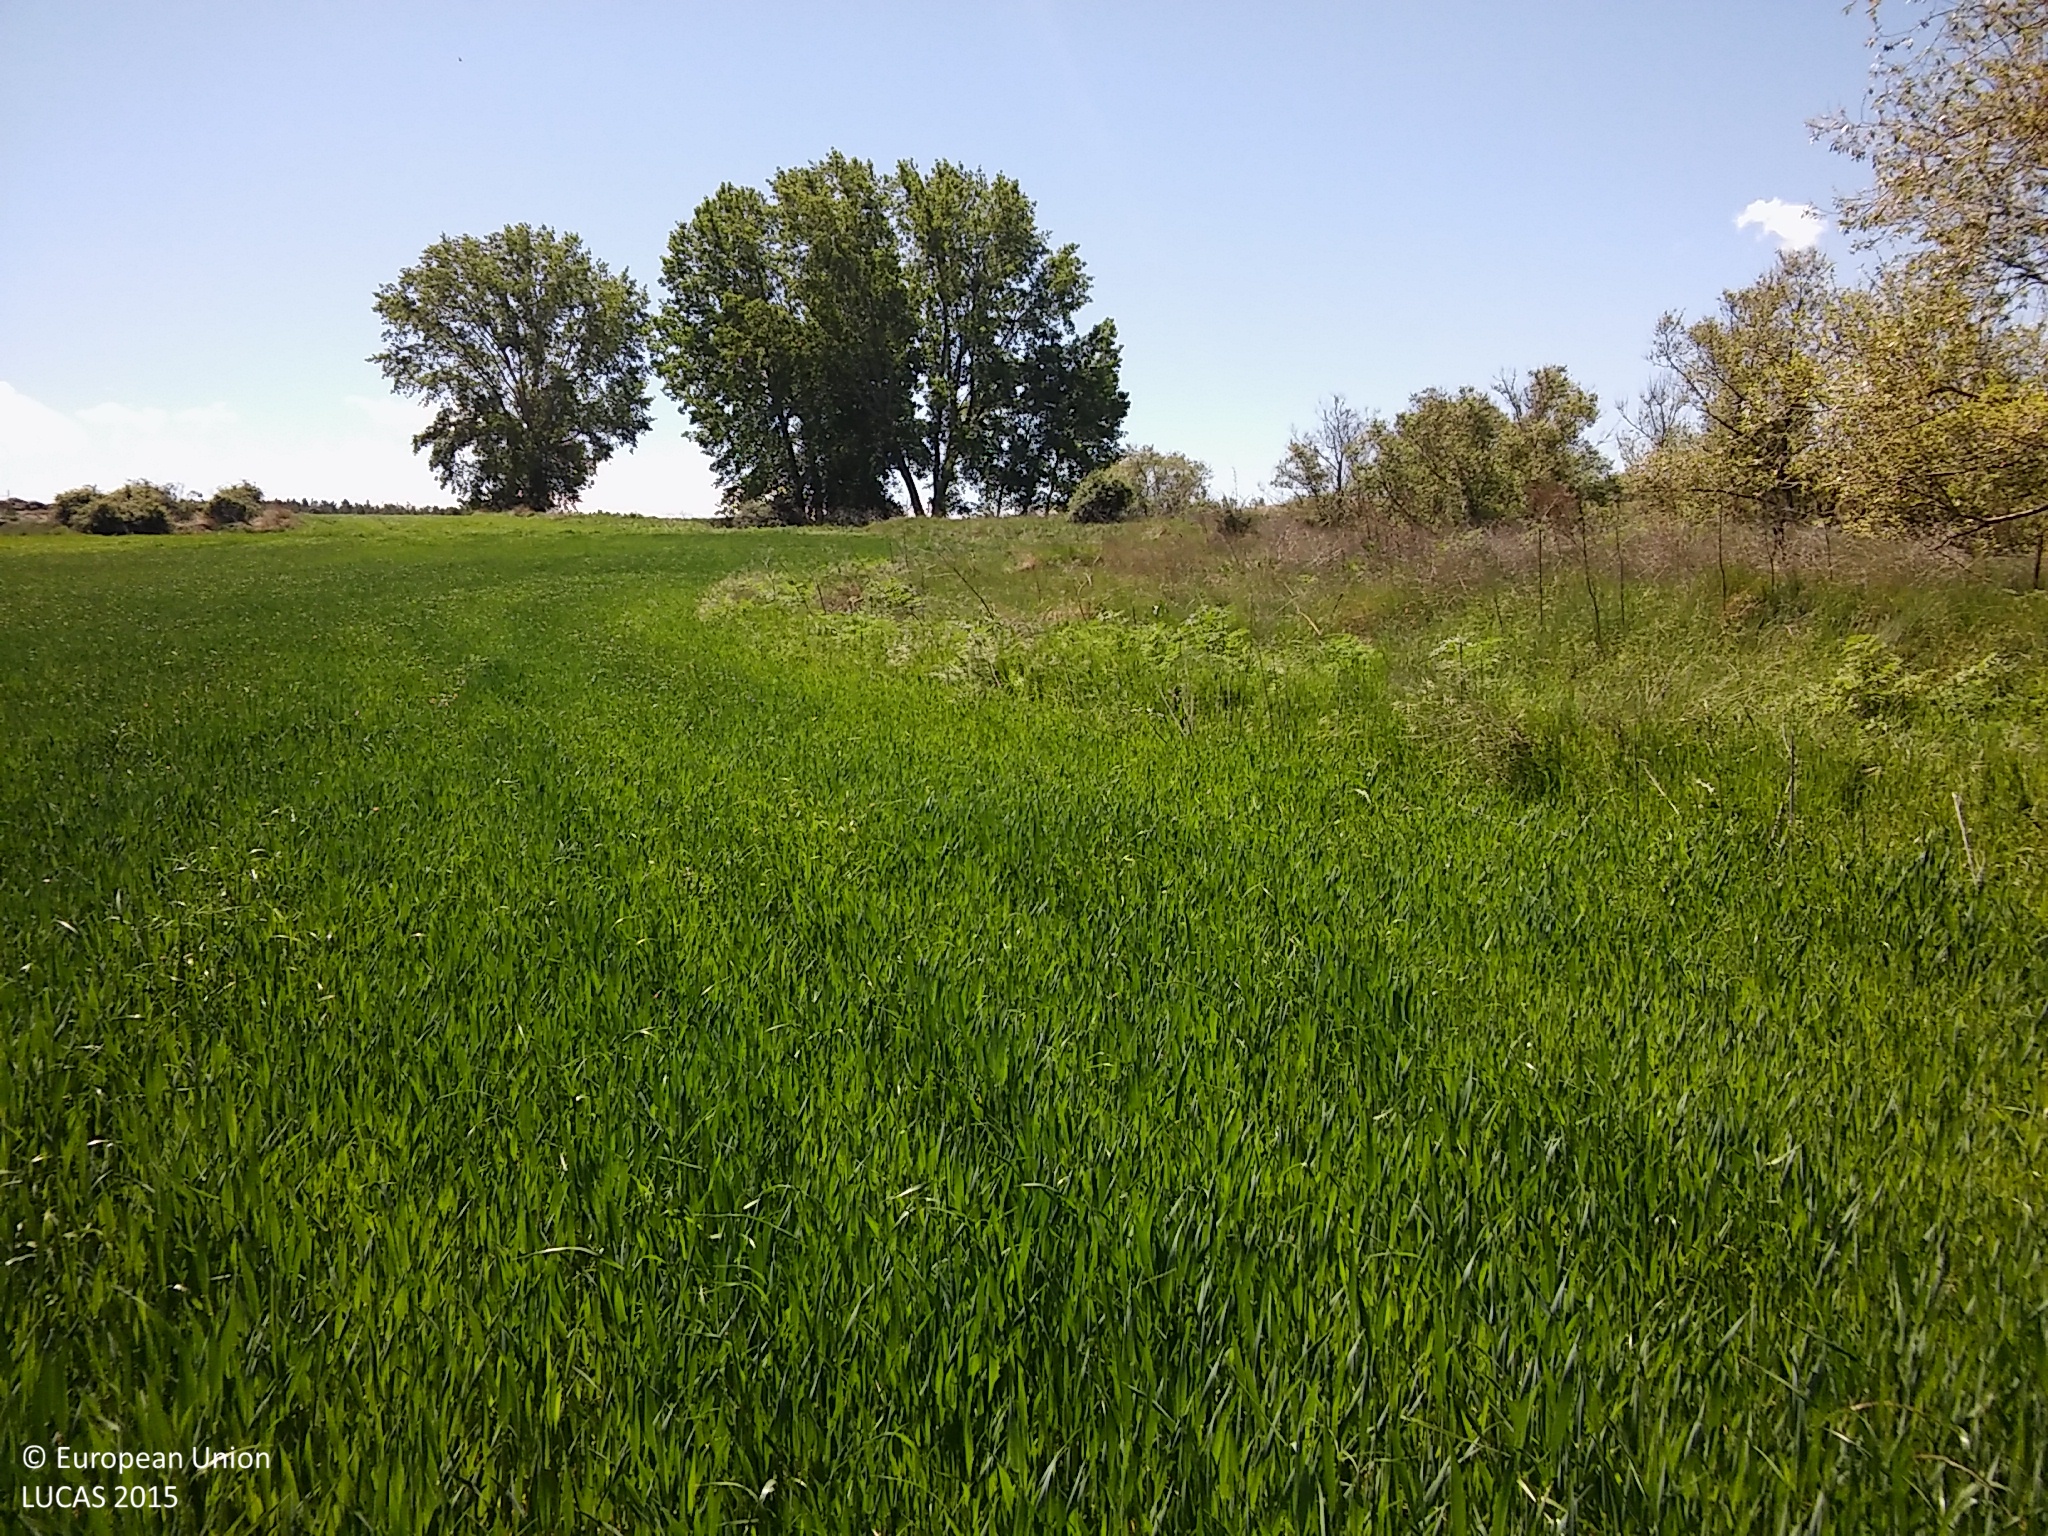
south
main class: Cropland
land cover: Common wheat
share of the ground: > 75 %
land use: Agriculture (excluding fallow land and kitchen gardens)
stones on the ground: < 10 %
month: May
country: ES
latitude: 41.1516
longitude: -3.9562
